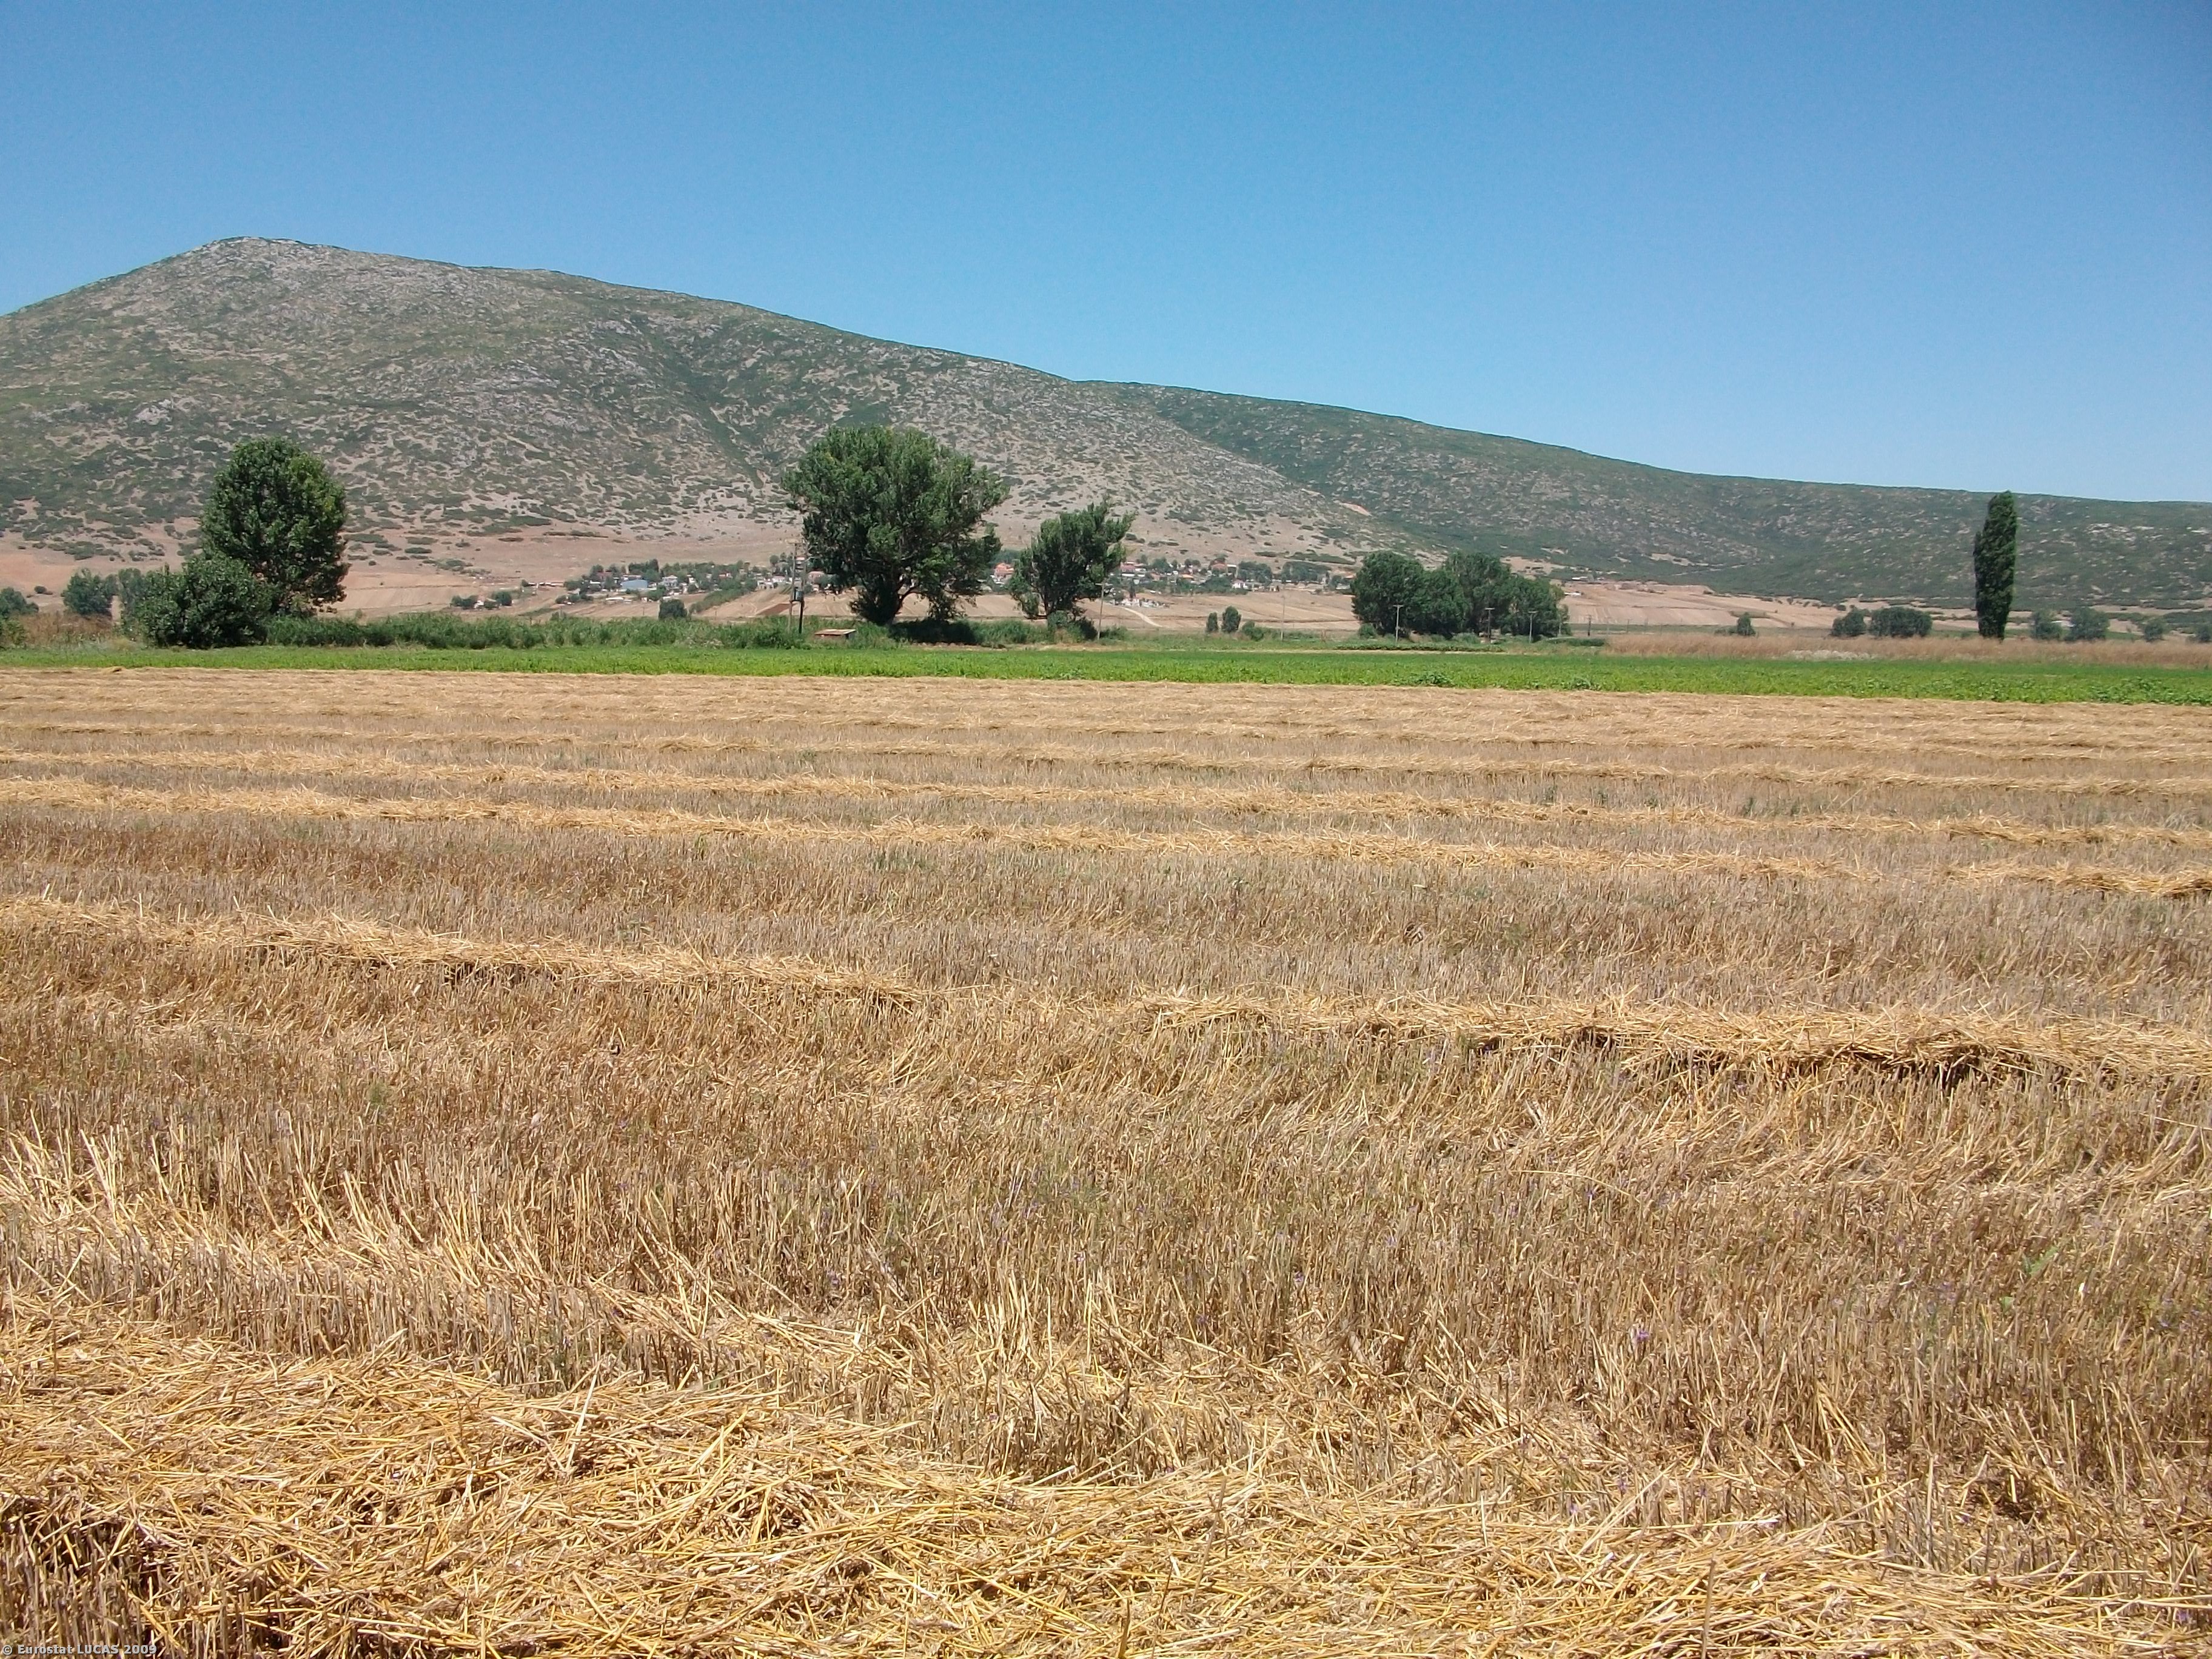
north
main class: Cropland
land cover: Durum wheat
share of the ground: > 75 %
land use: Agriculture (excluding fallow land and kitchen gardens)
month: July
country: GR
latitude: 39.0795
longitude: 22.2229
